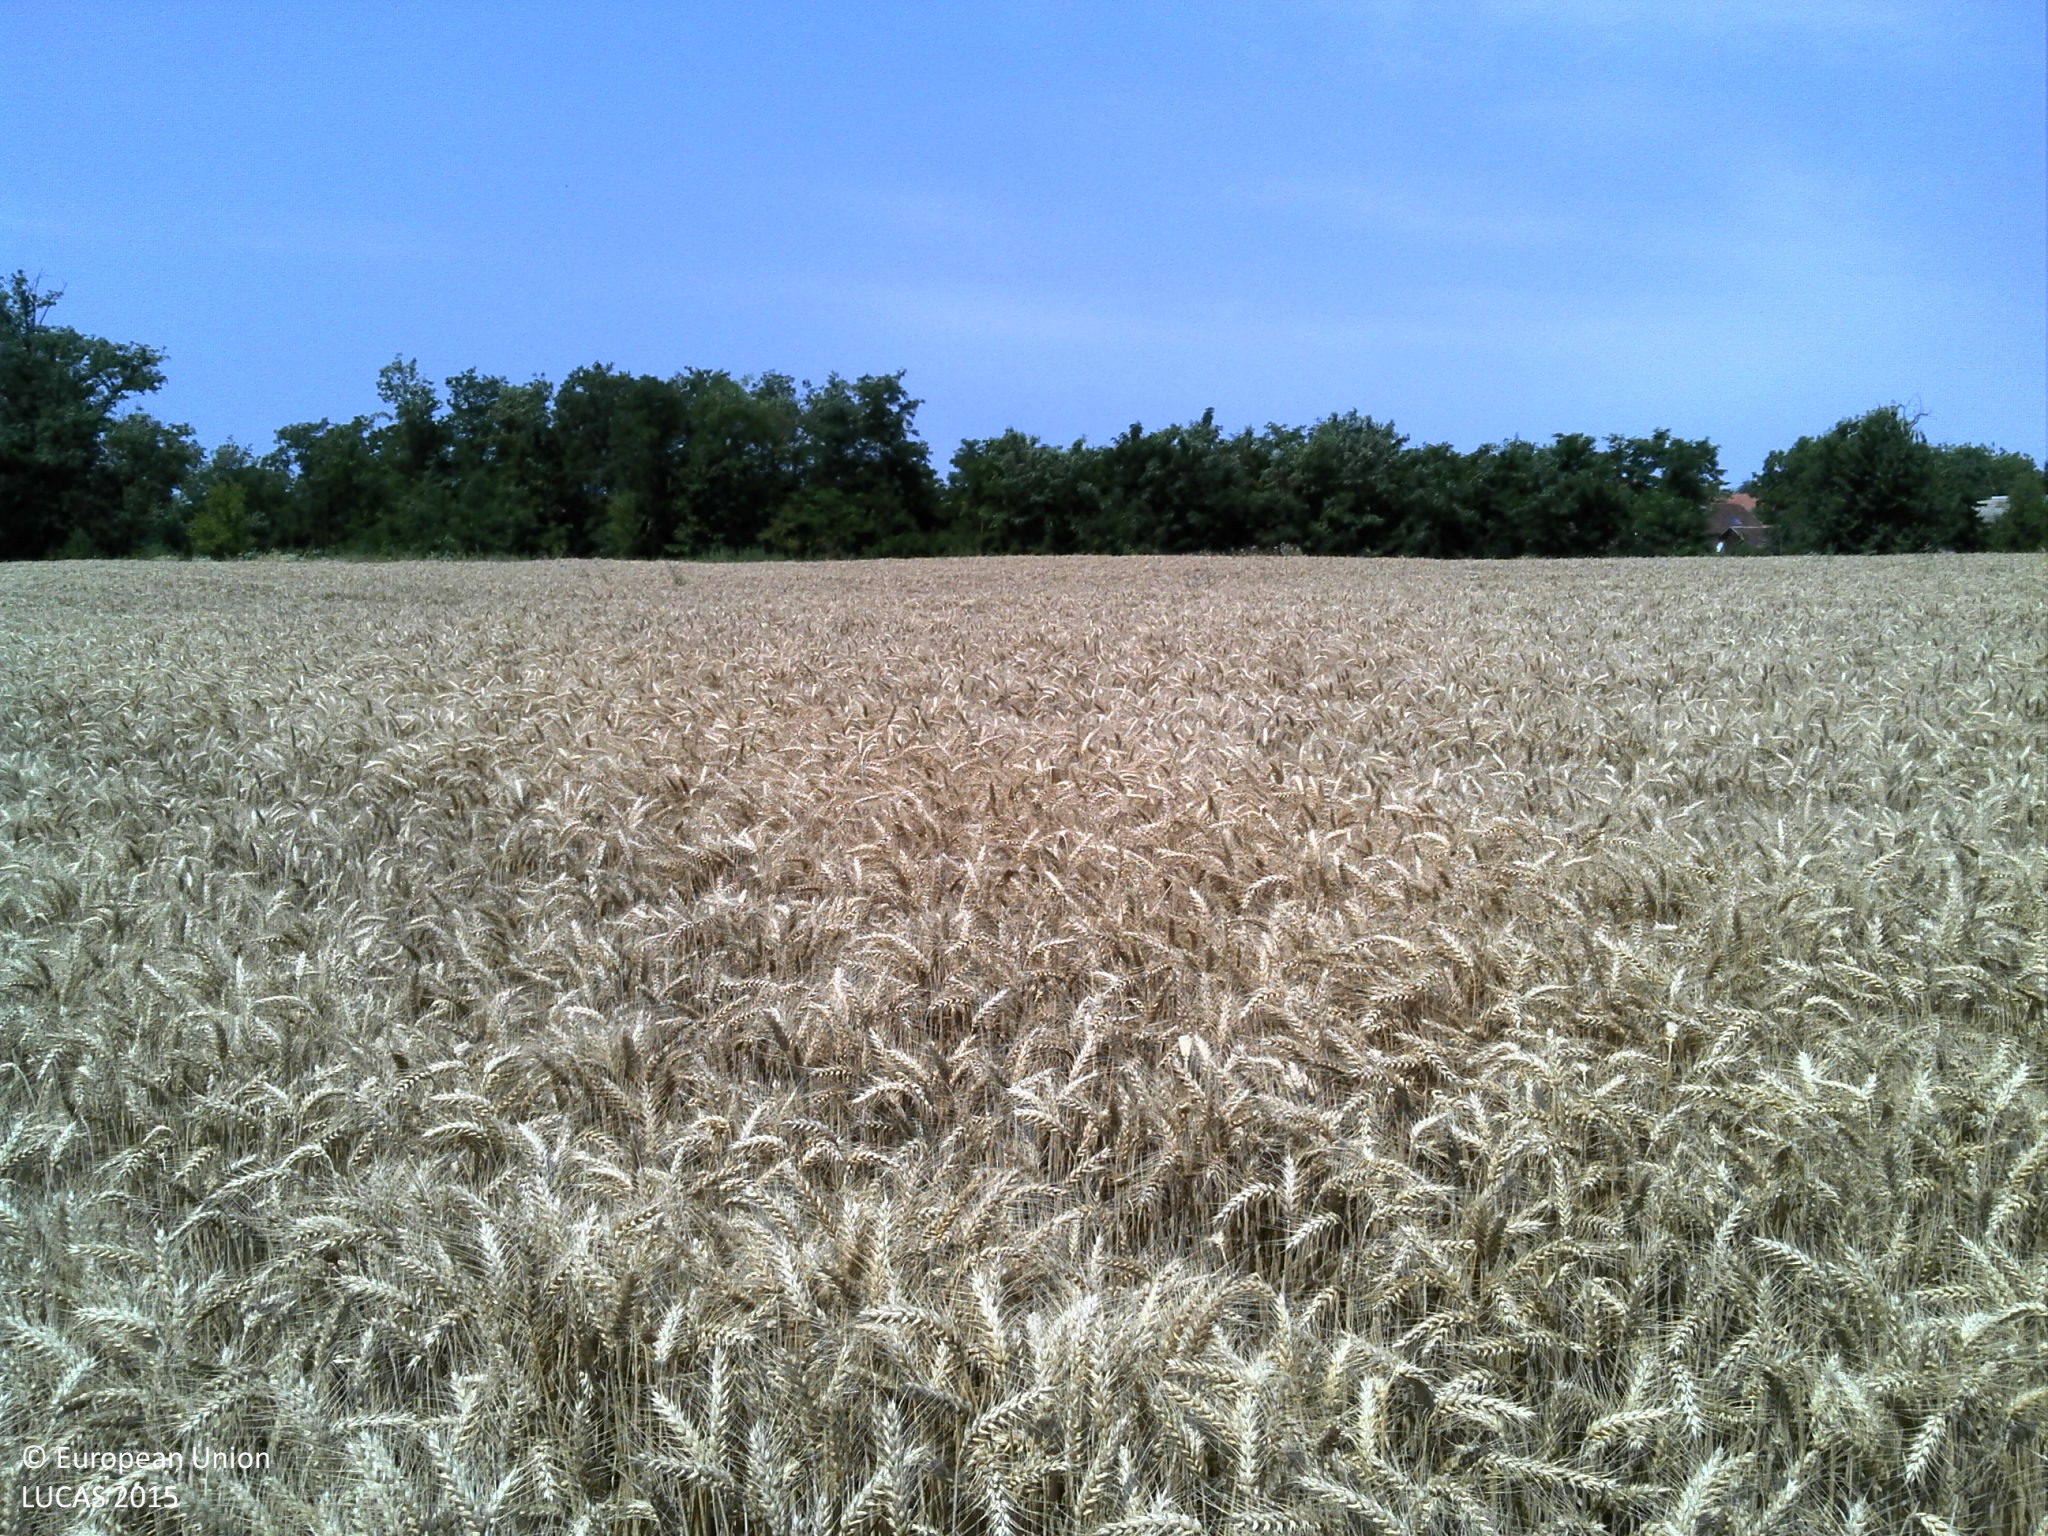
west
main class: Cropland
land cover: Common wheat
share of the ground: > 75 %
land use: Agriculture (excluding fallow land and kitchen gardens)
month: July
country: HR
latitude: 45.3010
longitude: 18.5630
